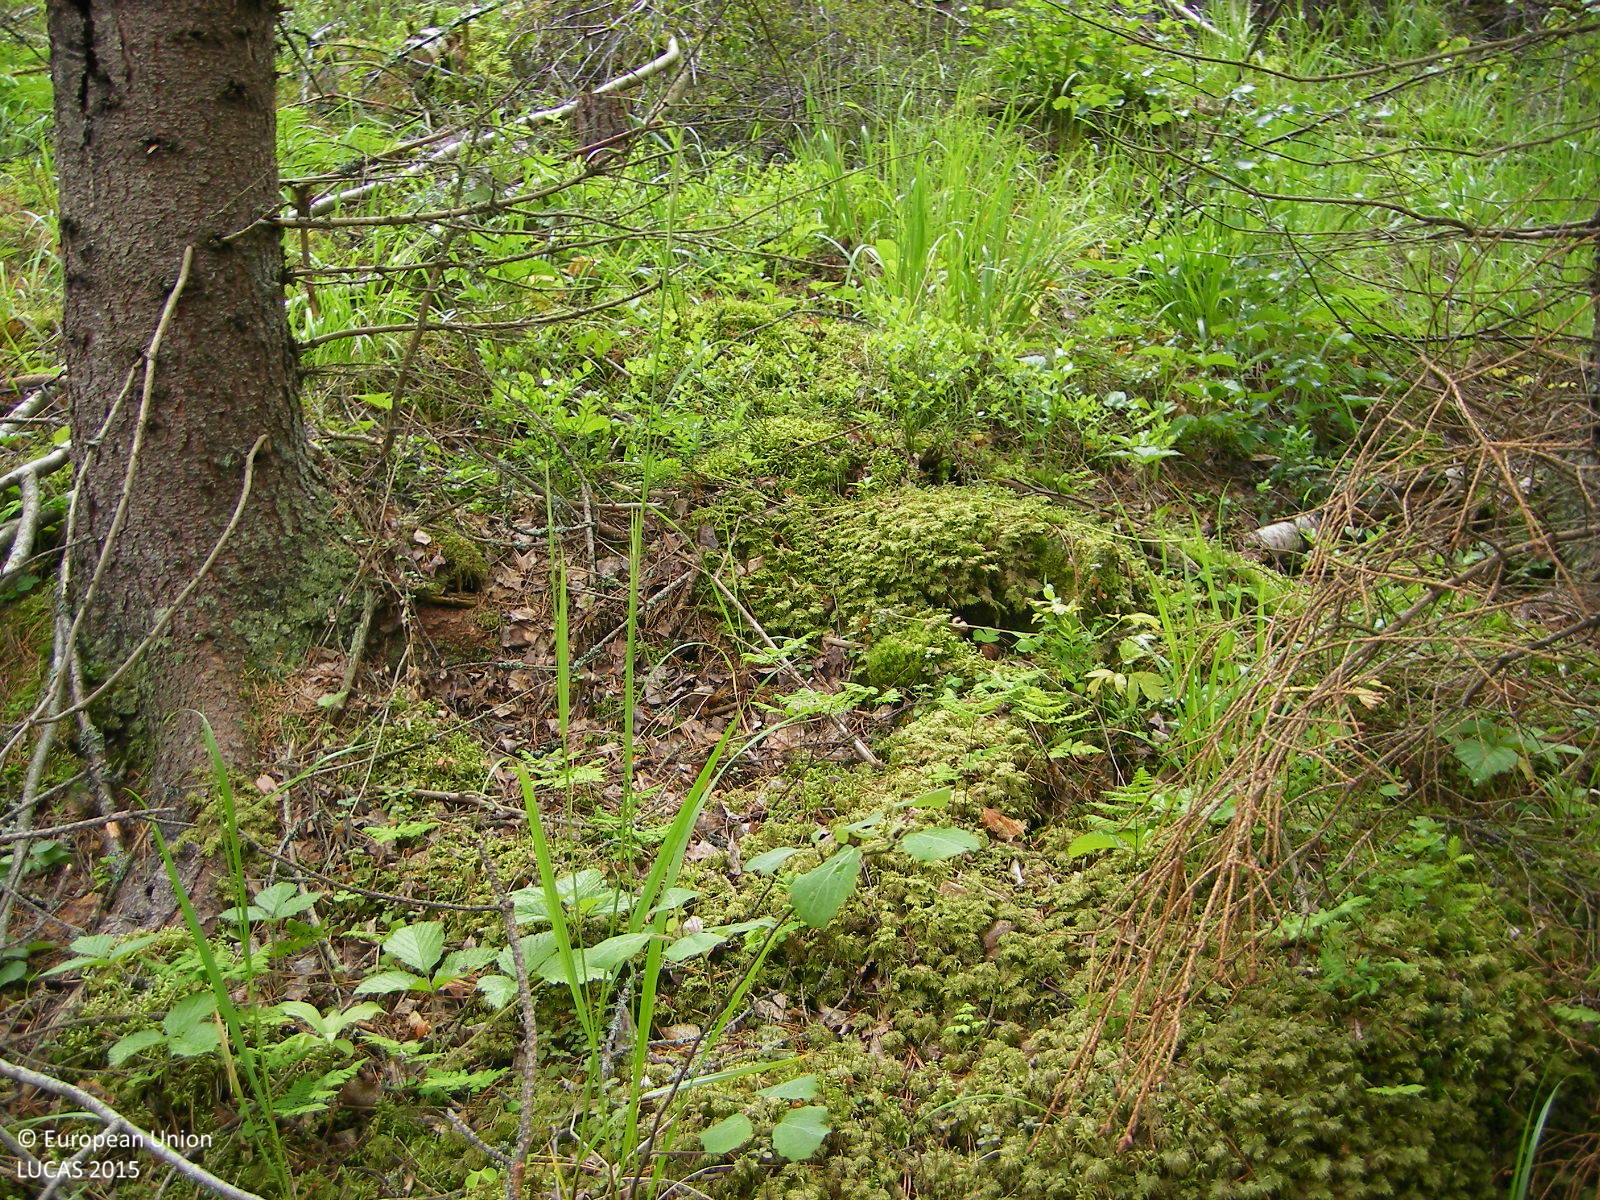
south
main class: Woodland
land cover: Other mixed woodland
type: boreal forest
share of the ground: > 75 %
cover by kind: coniferous forest trees 50 %, broadleaved forest trees 25 %, lichens and mosses 15 %, shrubs 5 %, herbaceous plants 5 %
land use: Forestry
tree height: > 5 m
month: June
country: FI
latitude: 60.3668
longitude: 23.3386
